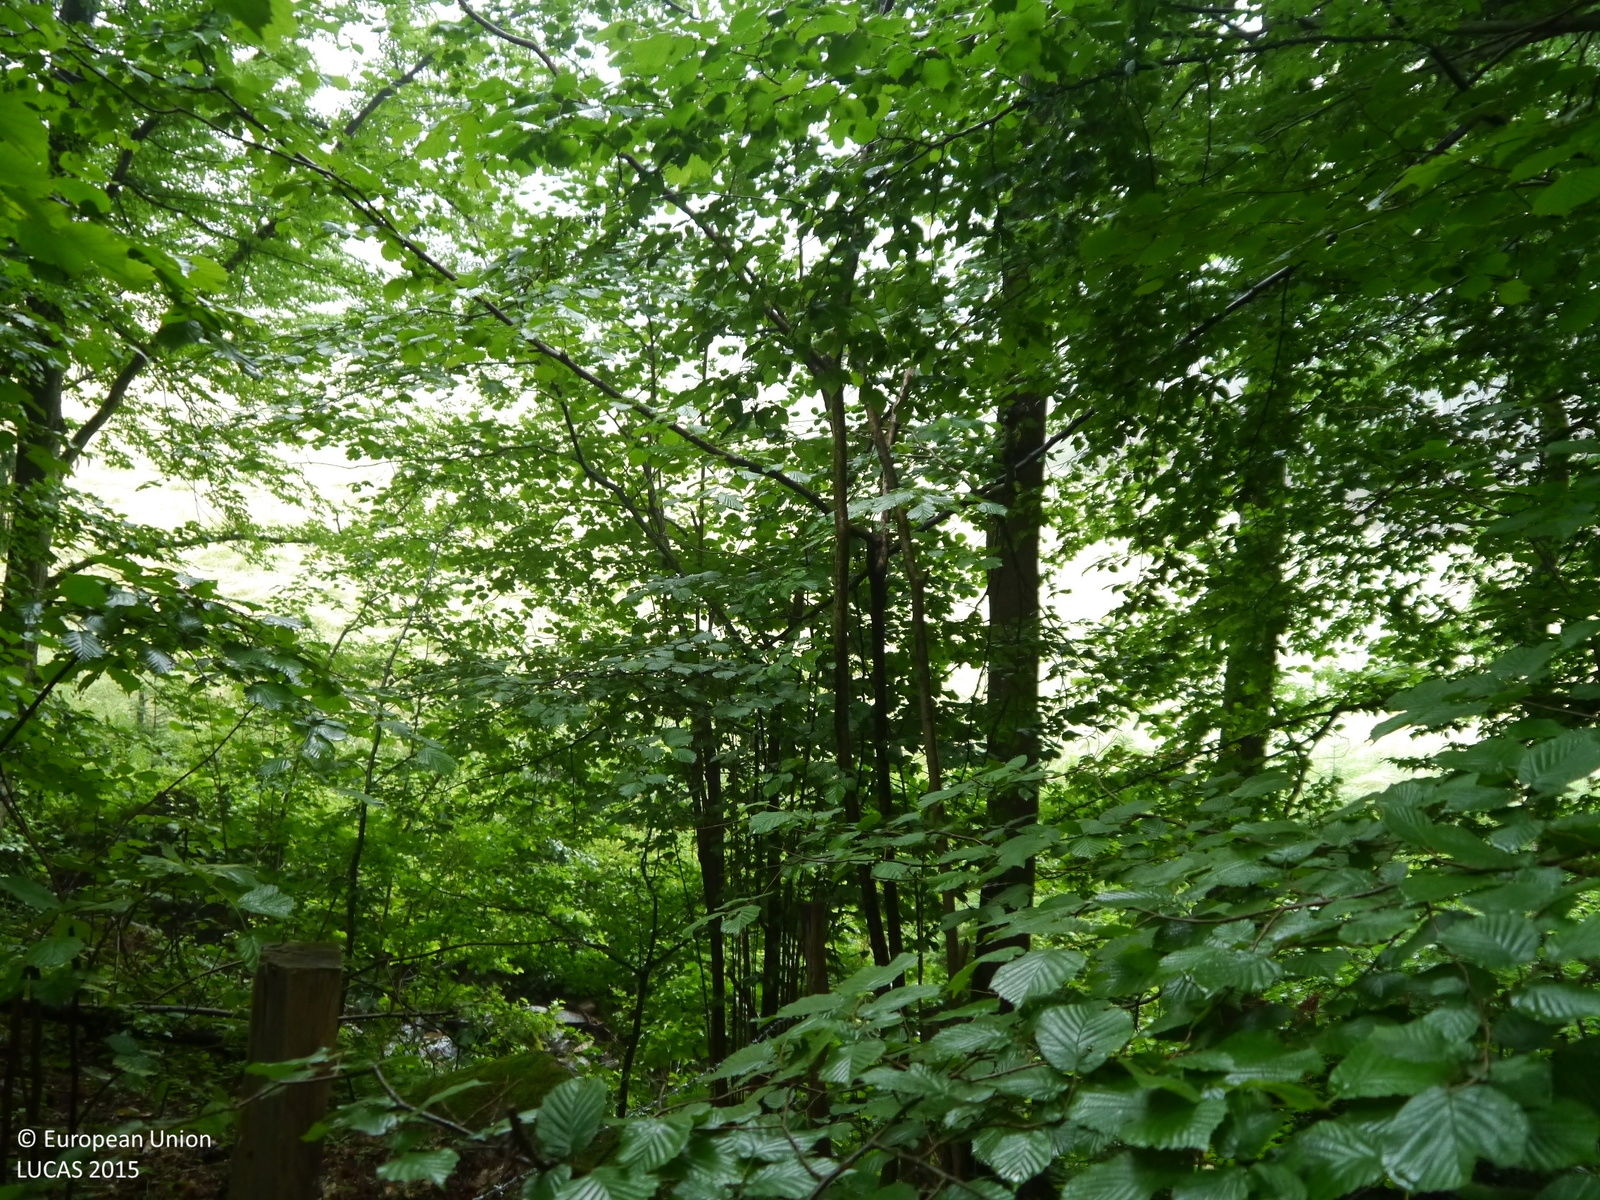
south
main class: Woodland
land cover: Spruce dominated mixed woodland
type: mountainous beech forest
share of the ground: > 75 %
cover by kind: coniferous forest trees 60 %, broadleaved forest trees 30 %, shrubs 5 %, herbaceous plants 5 %
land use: Forestry
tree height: > 5 m
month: June
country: AT
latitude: 46.6560
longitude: 15.2387
